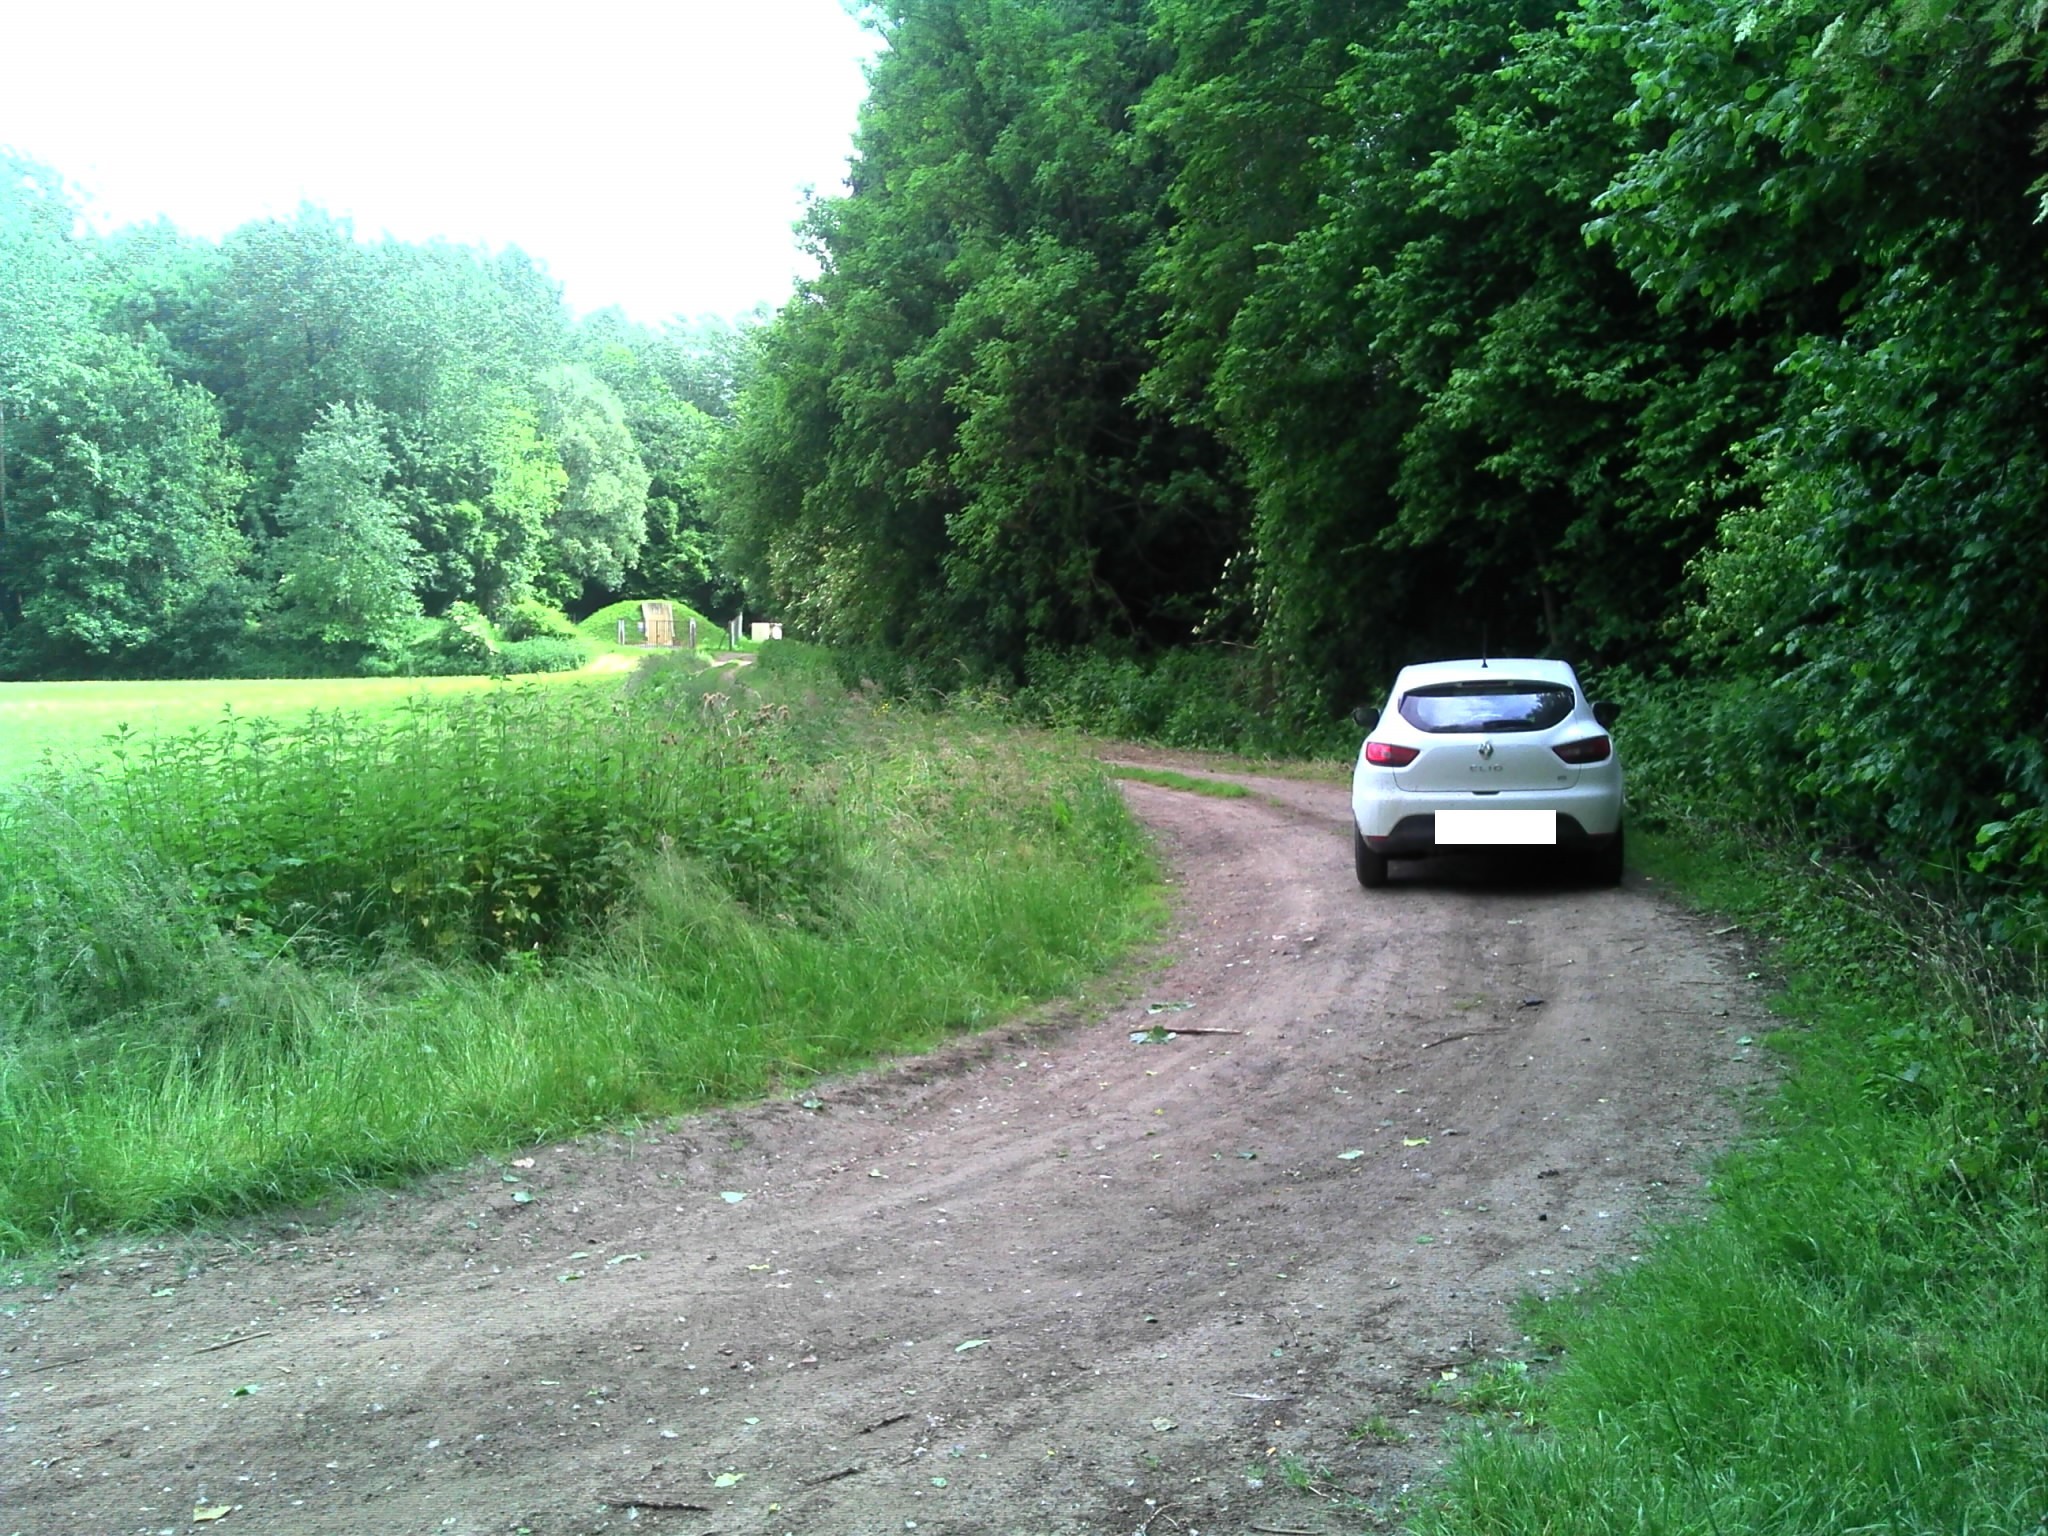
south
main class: Woodland
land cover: Broadleaved woodland
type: mesophytic deciduous forest
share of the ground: > 75 %
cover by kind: broadleaved forest trees 100 %
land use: Forestry
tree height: > 5 m
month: June
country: FR
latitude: 49.6053
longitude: 3.2527
